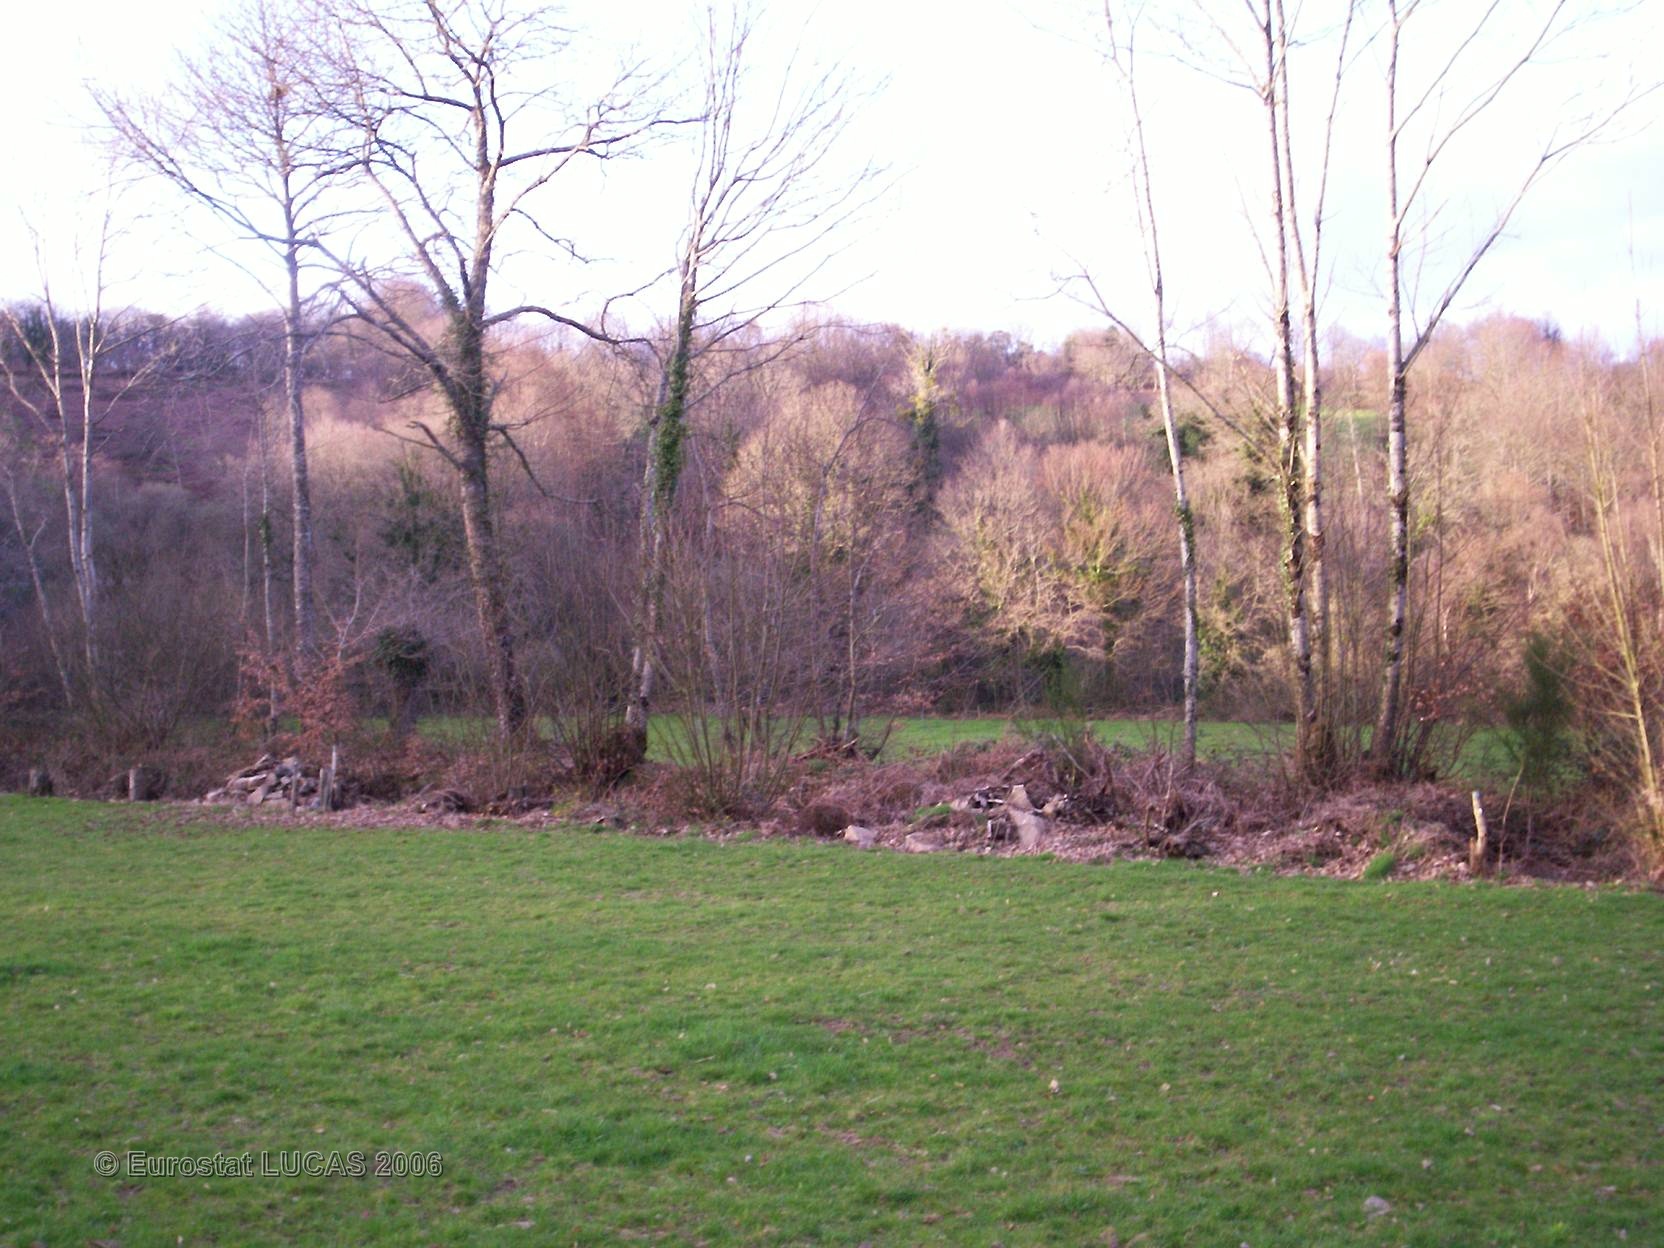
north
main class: Grassland
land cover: Grassland without tree/shrub cover
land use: Agriculture (excluding fallow land and kitchen gardens)
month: April
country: FR
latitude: 48.0237
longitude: -3.5262
